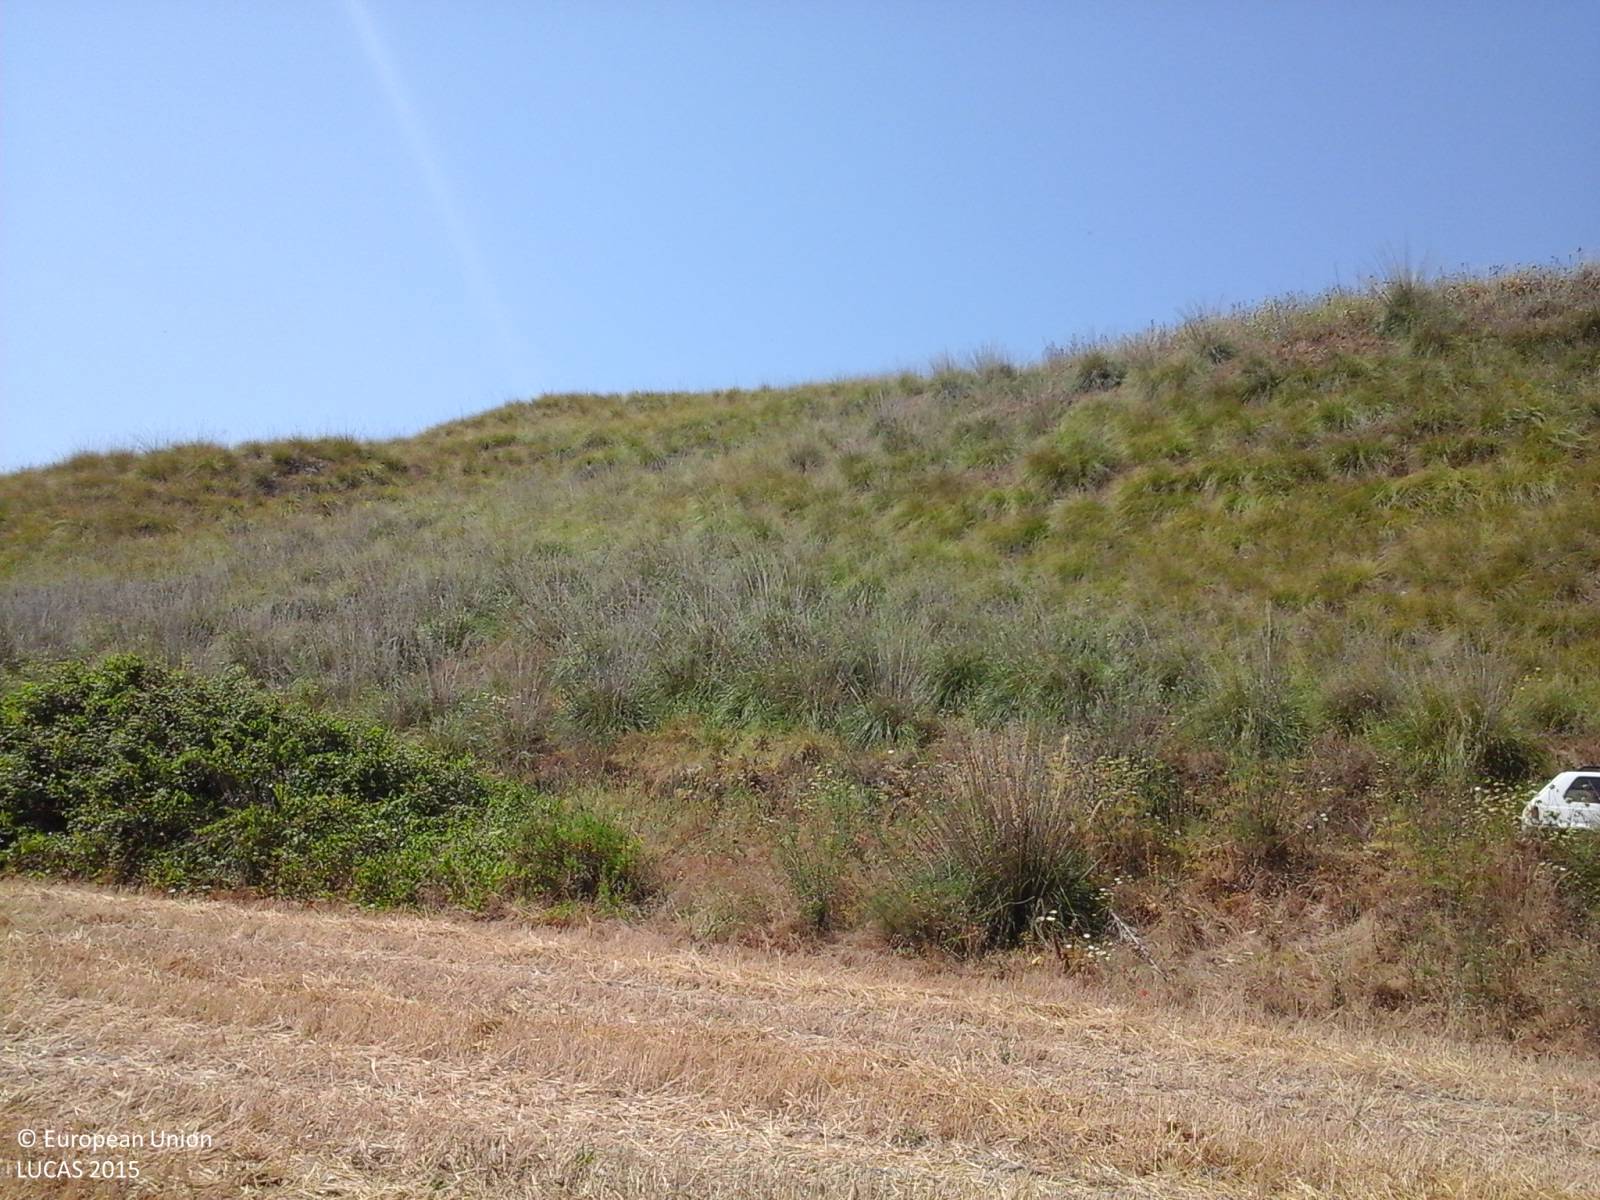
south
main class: Cropland
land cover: Durum wheat
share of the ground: > 75 %
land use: Agriculture (excluding fallow land and kitchen gardens)
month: July
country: IT
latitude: 37.8038
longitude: 13.1682
